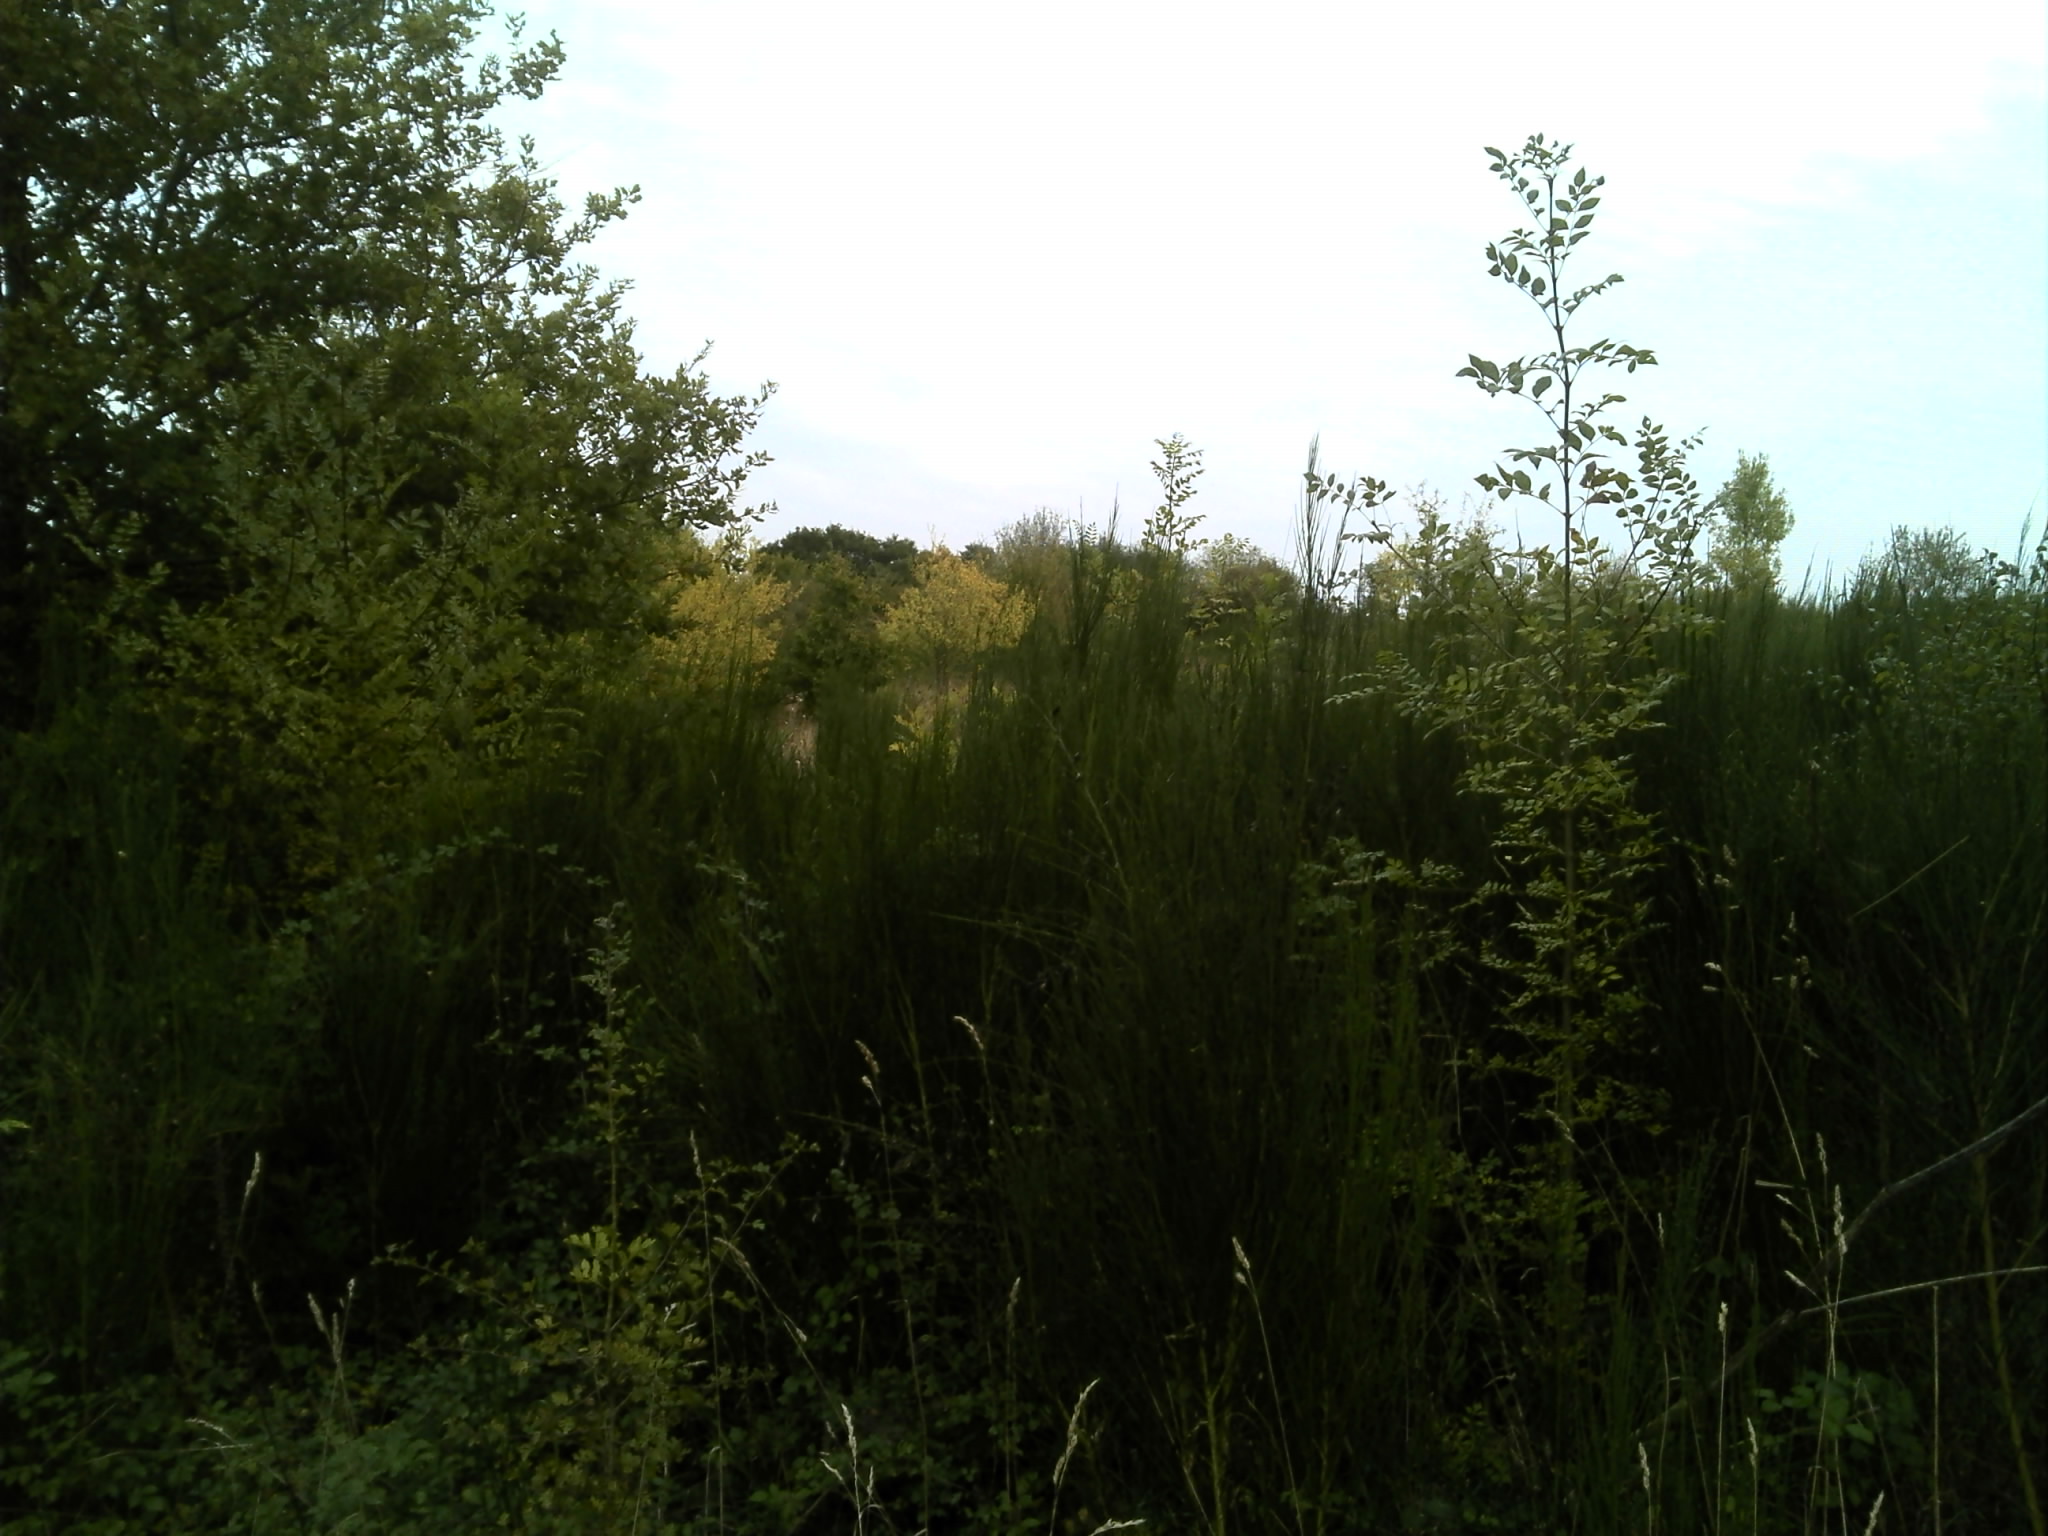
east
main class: Shrubland
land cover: Shrubland with sparse tree cover
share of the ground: > 75 %
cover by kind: shrubs 55 %, herbaceous plants 40 %, broadleaved forest trees 5 %
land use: Semi-natural and natural areas not in use
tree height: > 5 m
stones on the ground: 10 - 25 %
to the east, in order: Shrubland with sparse tree cover; Spontaneously vegetated surfaces; Broadleaved woodland; Spontaneously vegetated surfaces; Fences; Grassland without tree/shrub cover; Single bushes/trees
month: October
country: FR
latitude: 47.4582
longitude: -0.9527
